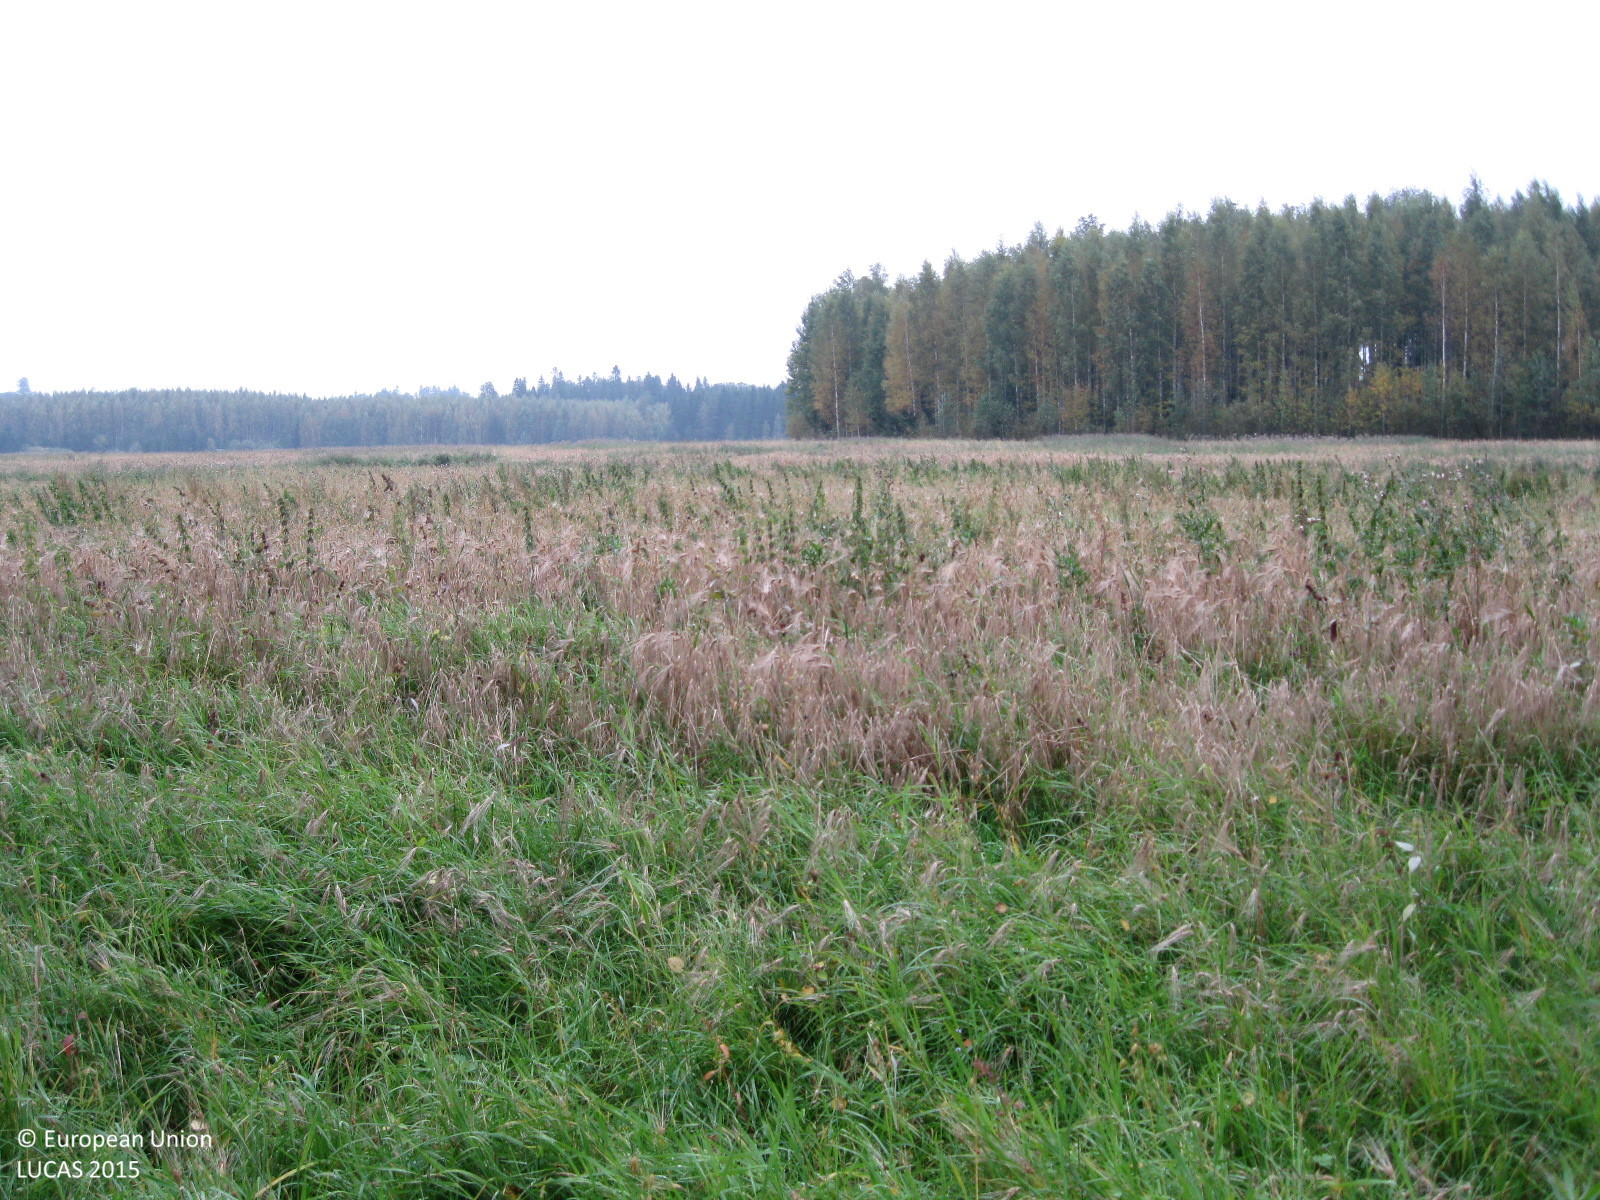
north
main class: Cropland
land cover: Barley
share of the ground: 50 - 75 %
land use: Agriculture (excluding fallow land and kitchen gardens)
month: September
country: FI
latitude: 60.8660
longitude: 24.5970
